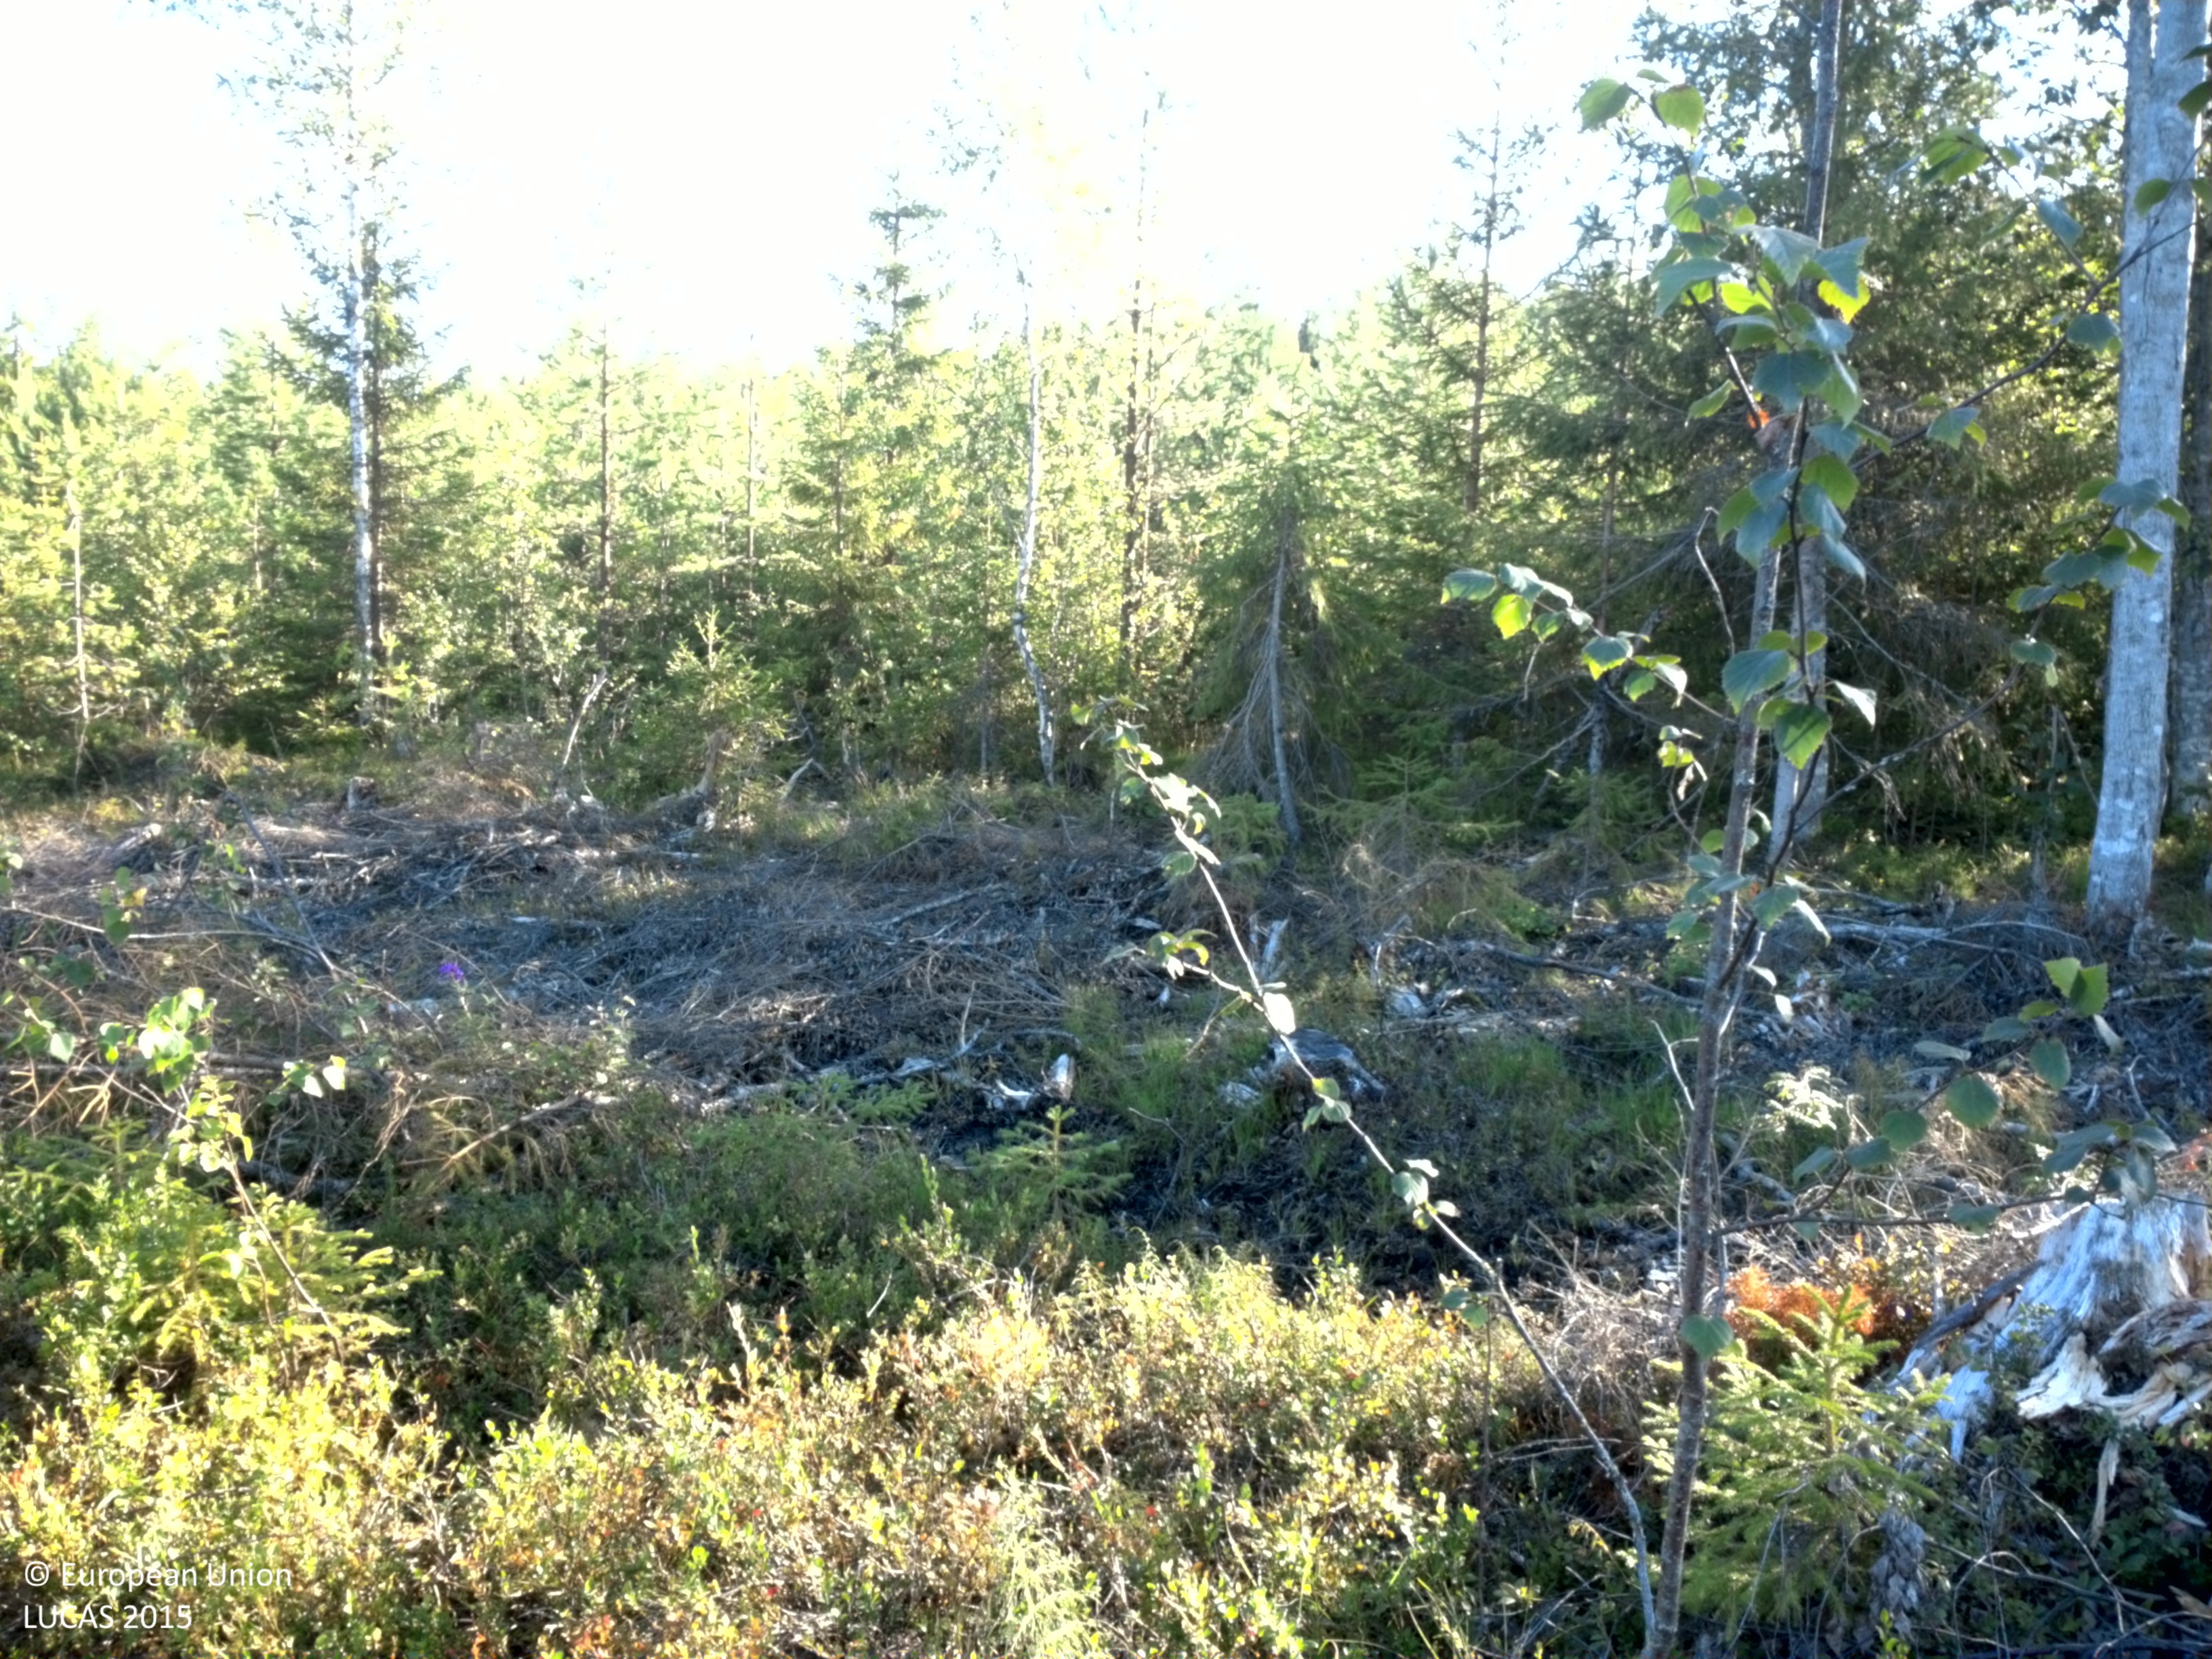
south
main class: Shrubland
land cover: Shrubland with sparse tree cover
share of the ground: > 75 %
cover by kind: shrubs 90 %, coniferous forest trees 5 %, herbaceous plants 5 %
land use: Forestry
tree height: < 5 m
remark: Clear cut
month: August
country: SE
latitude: 64.5674
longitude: 20.9364
